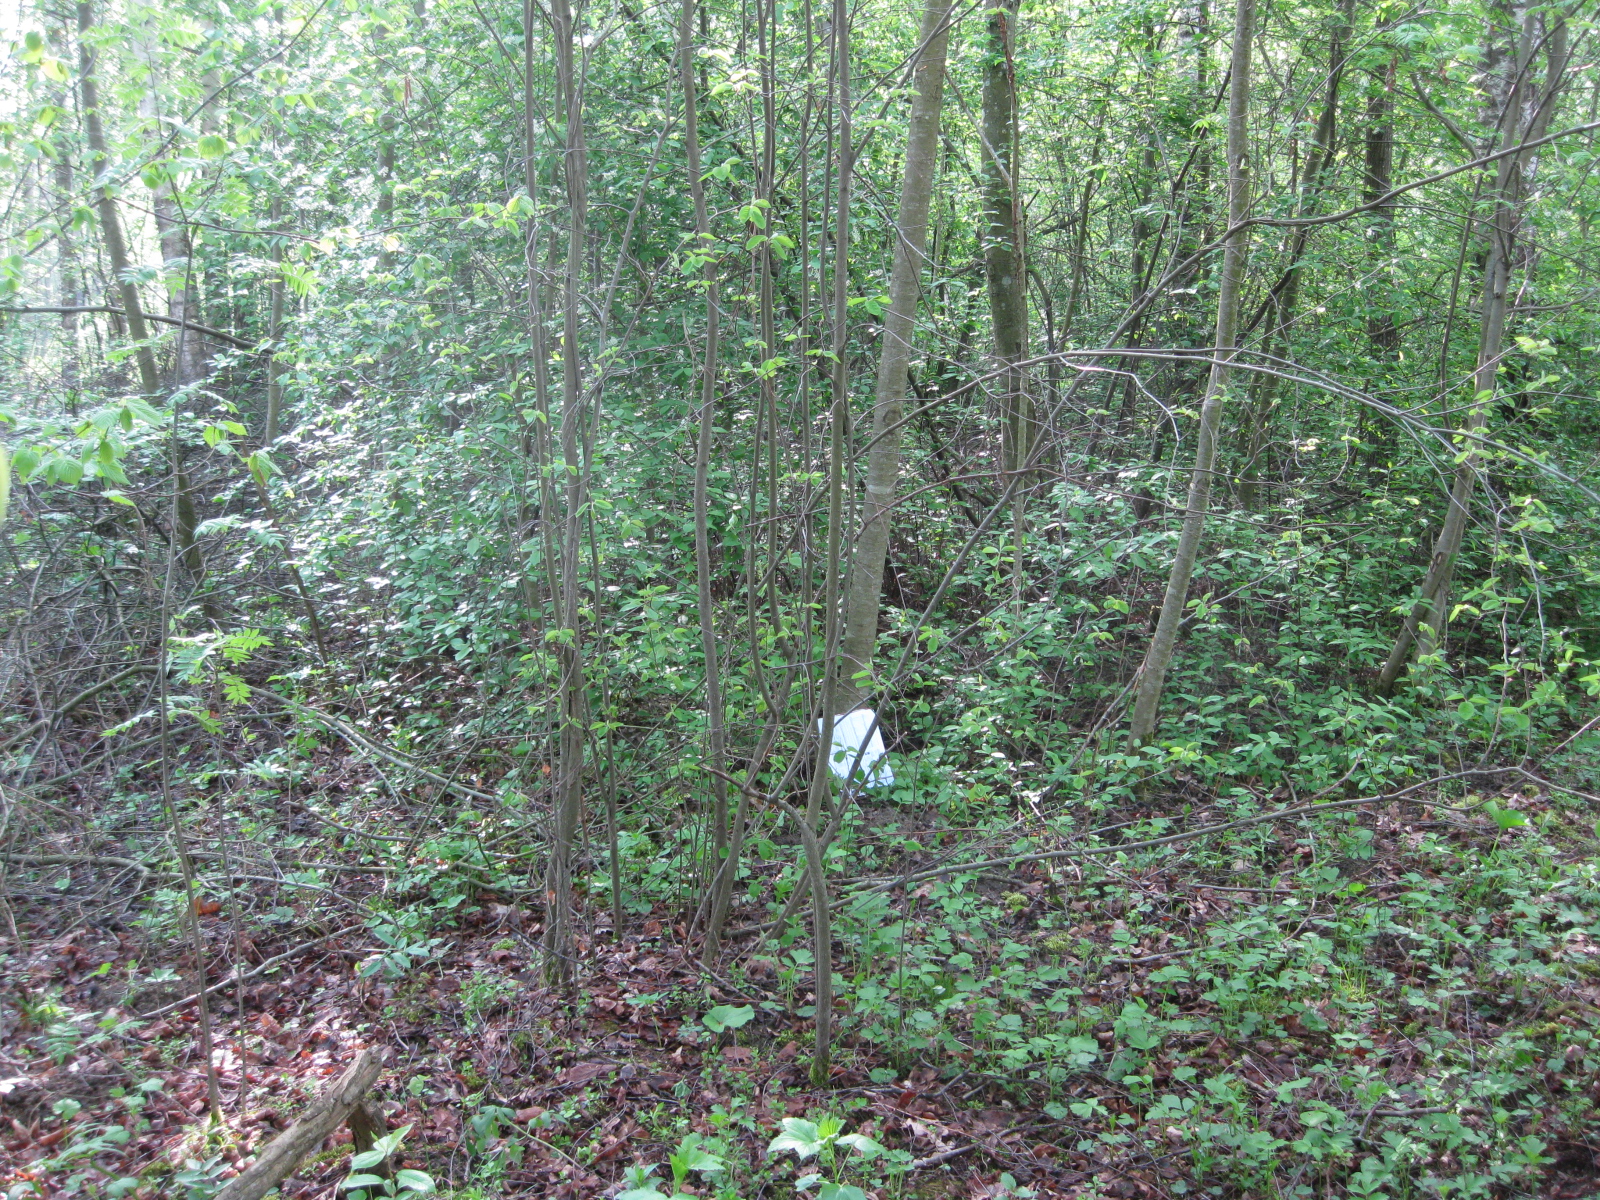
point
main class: Woodland
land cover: Broadleaved woodland
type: non-riverine alder, birch or aspen forest
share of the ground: > 75 %
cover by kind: broadleaved forest trees 90 %, herbaceous plants 10 %
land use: Forestry
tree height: > 5 m
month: May
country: LT
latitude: 56.2397
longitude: 24.4727
